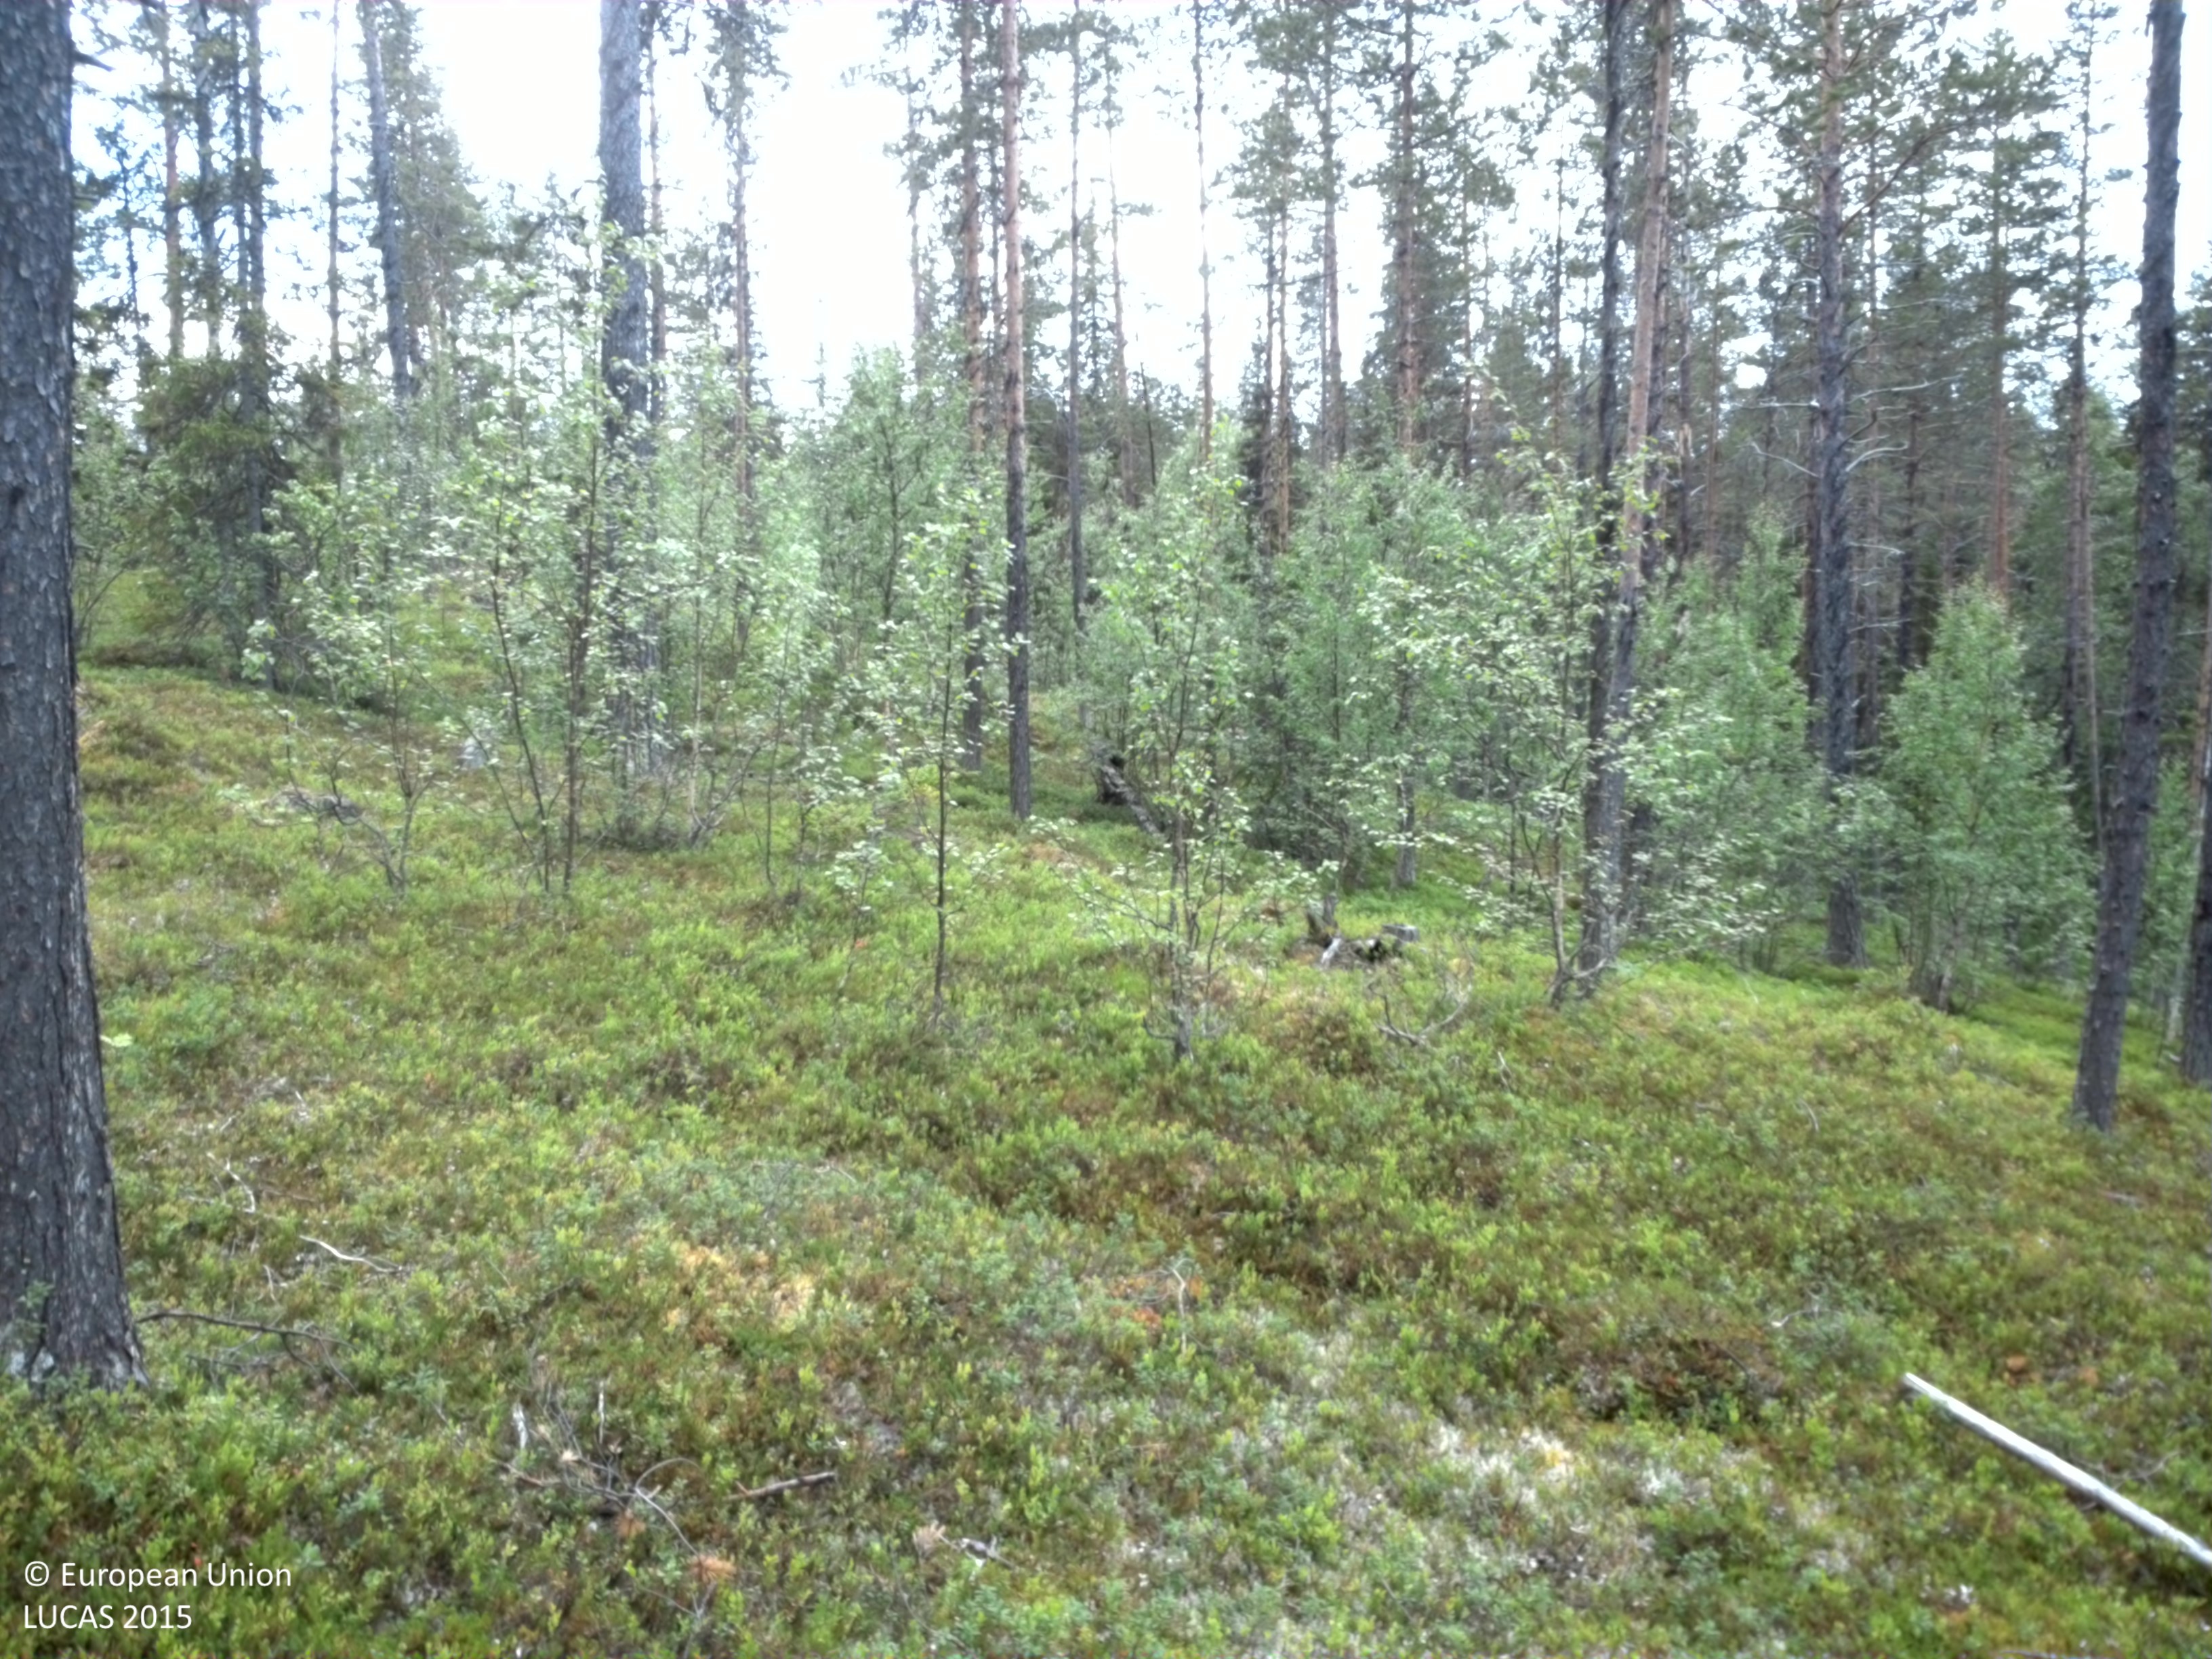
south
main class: Woodland
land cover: Pine dominated mixed woodland
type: boreal forest
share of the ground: 10 - 25 %
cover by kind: shrubs 40 %, lichens and mosses 30 %, coniferous forest trees 20 %, broadleaved forest trees 10 %
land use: Forestry
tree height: > 5 m
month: August
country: SE
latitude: 65.0762
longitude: 16.1538
